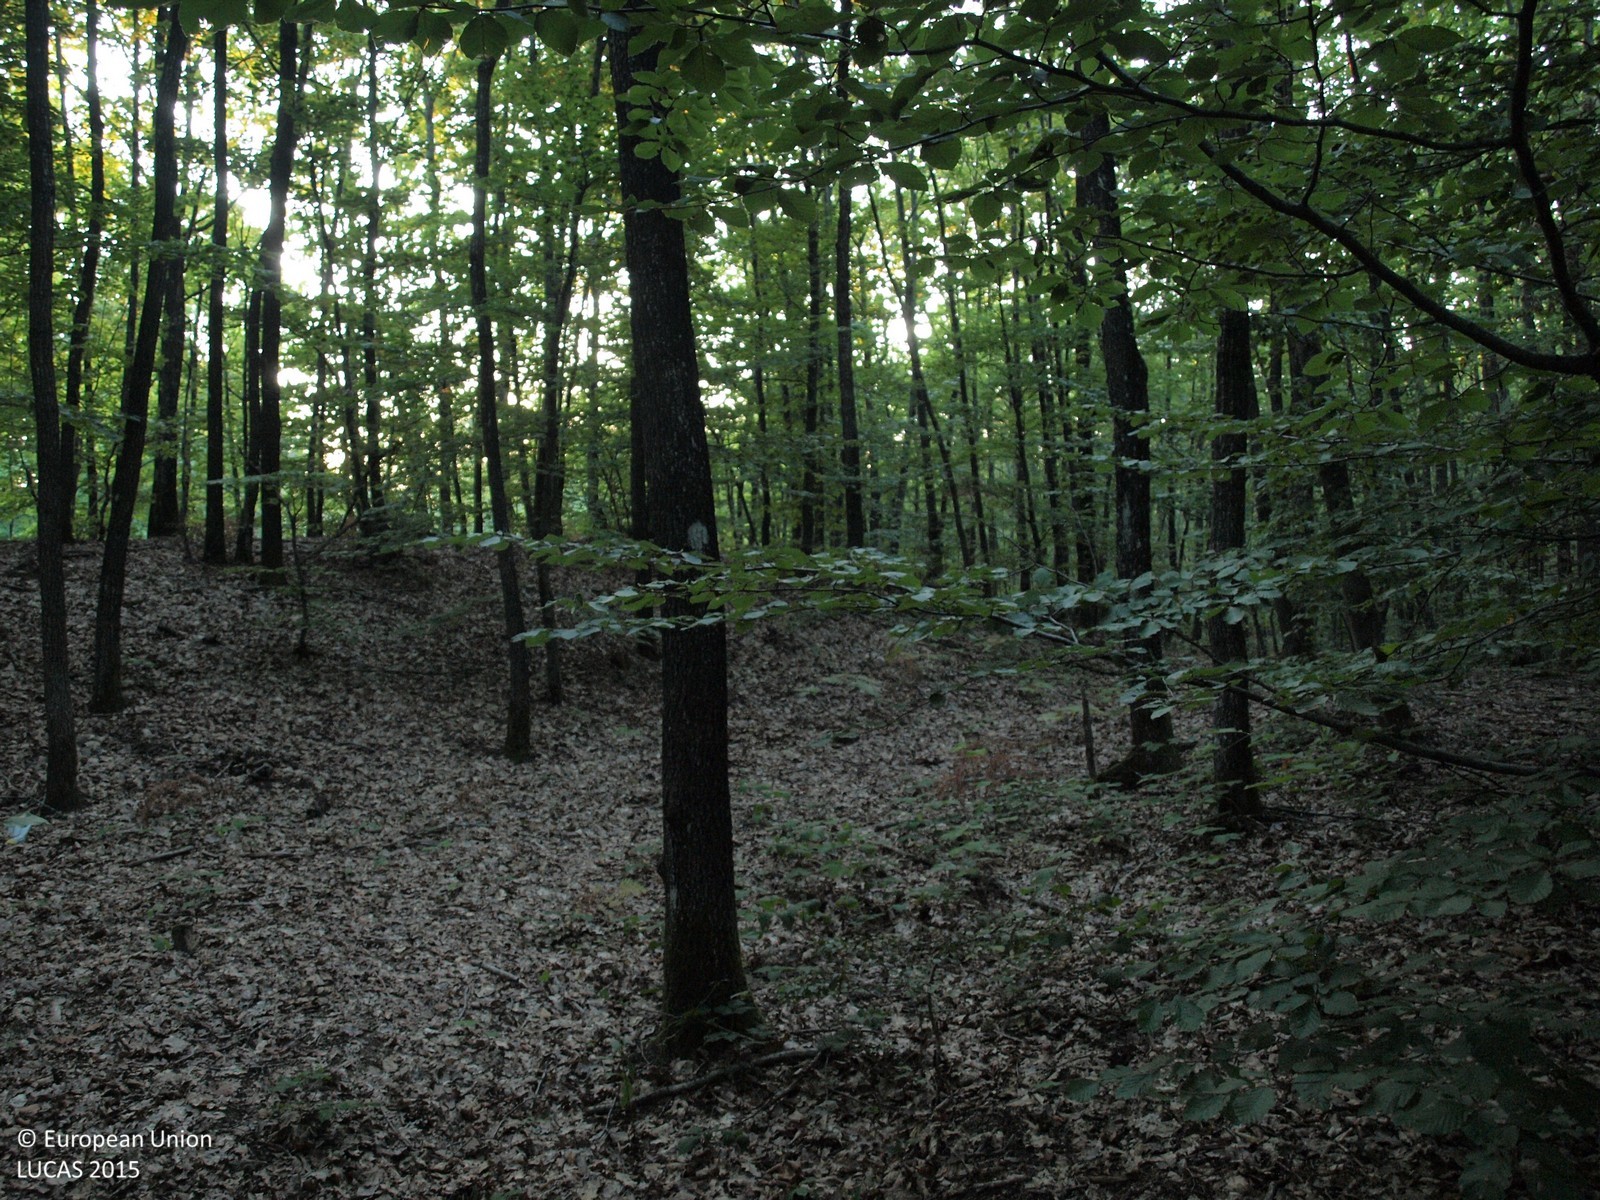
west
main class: Woodland
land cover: Broadleaved woodland
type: mesophytic deciduous forest
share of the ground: > 75 %
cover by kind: broadleaved forest trees 100 %
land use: Forestry
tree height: > 5 m
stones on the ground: < 10 %
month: September
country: HR
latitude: 45.5294
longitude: 16.0537
